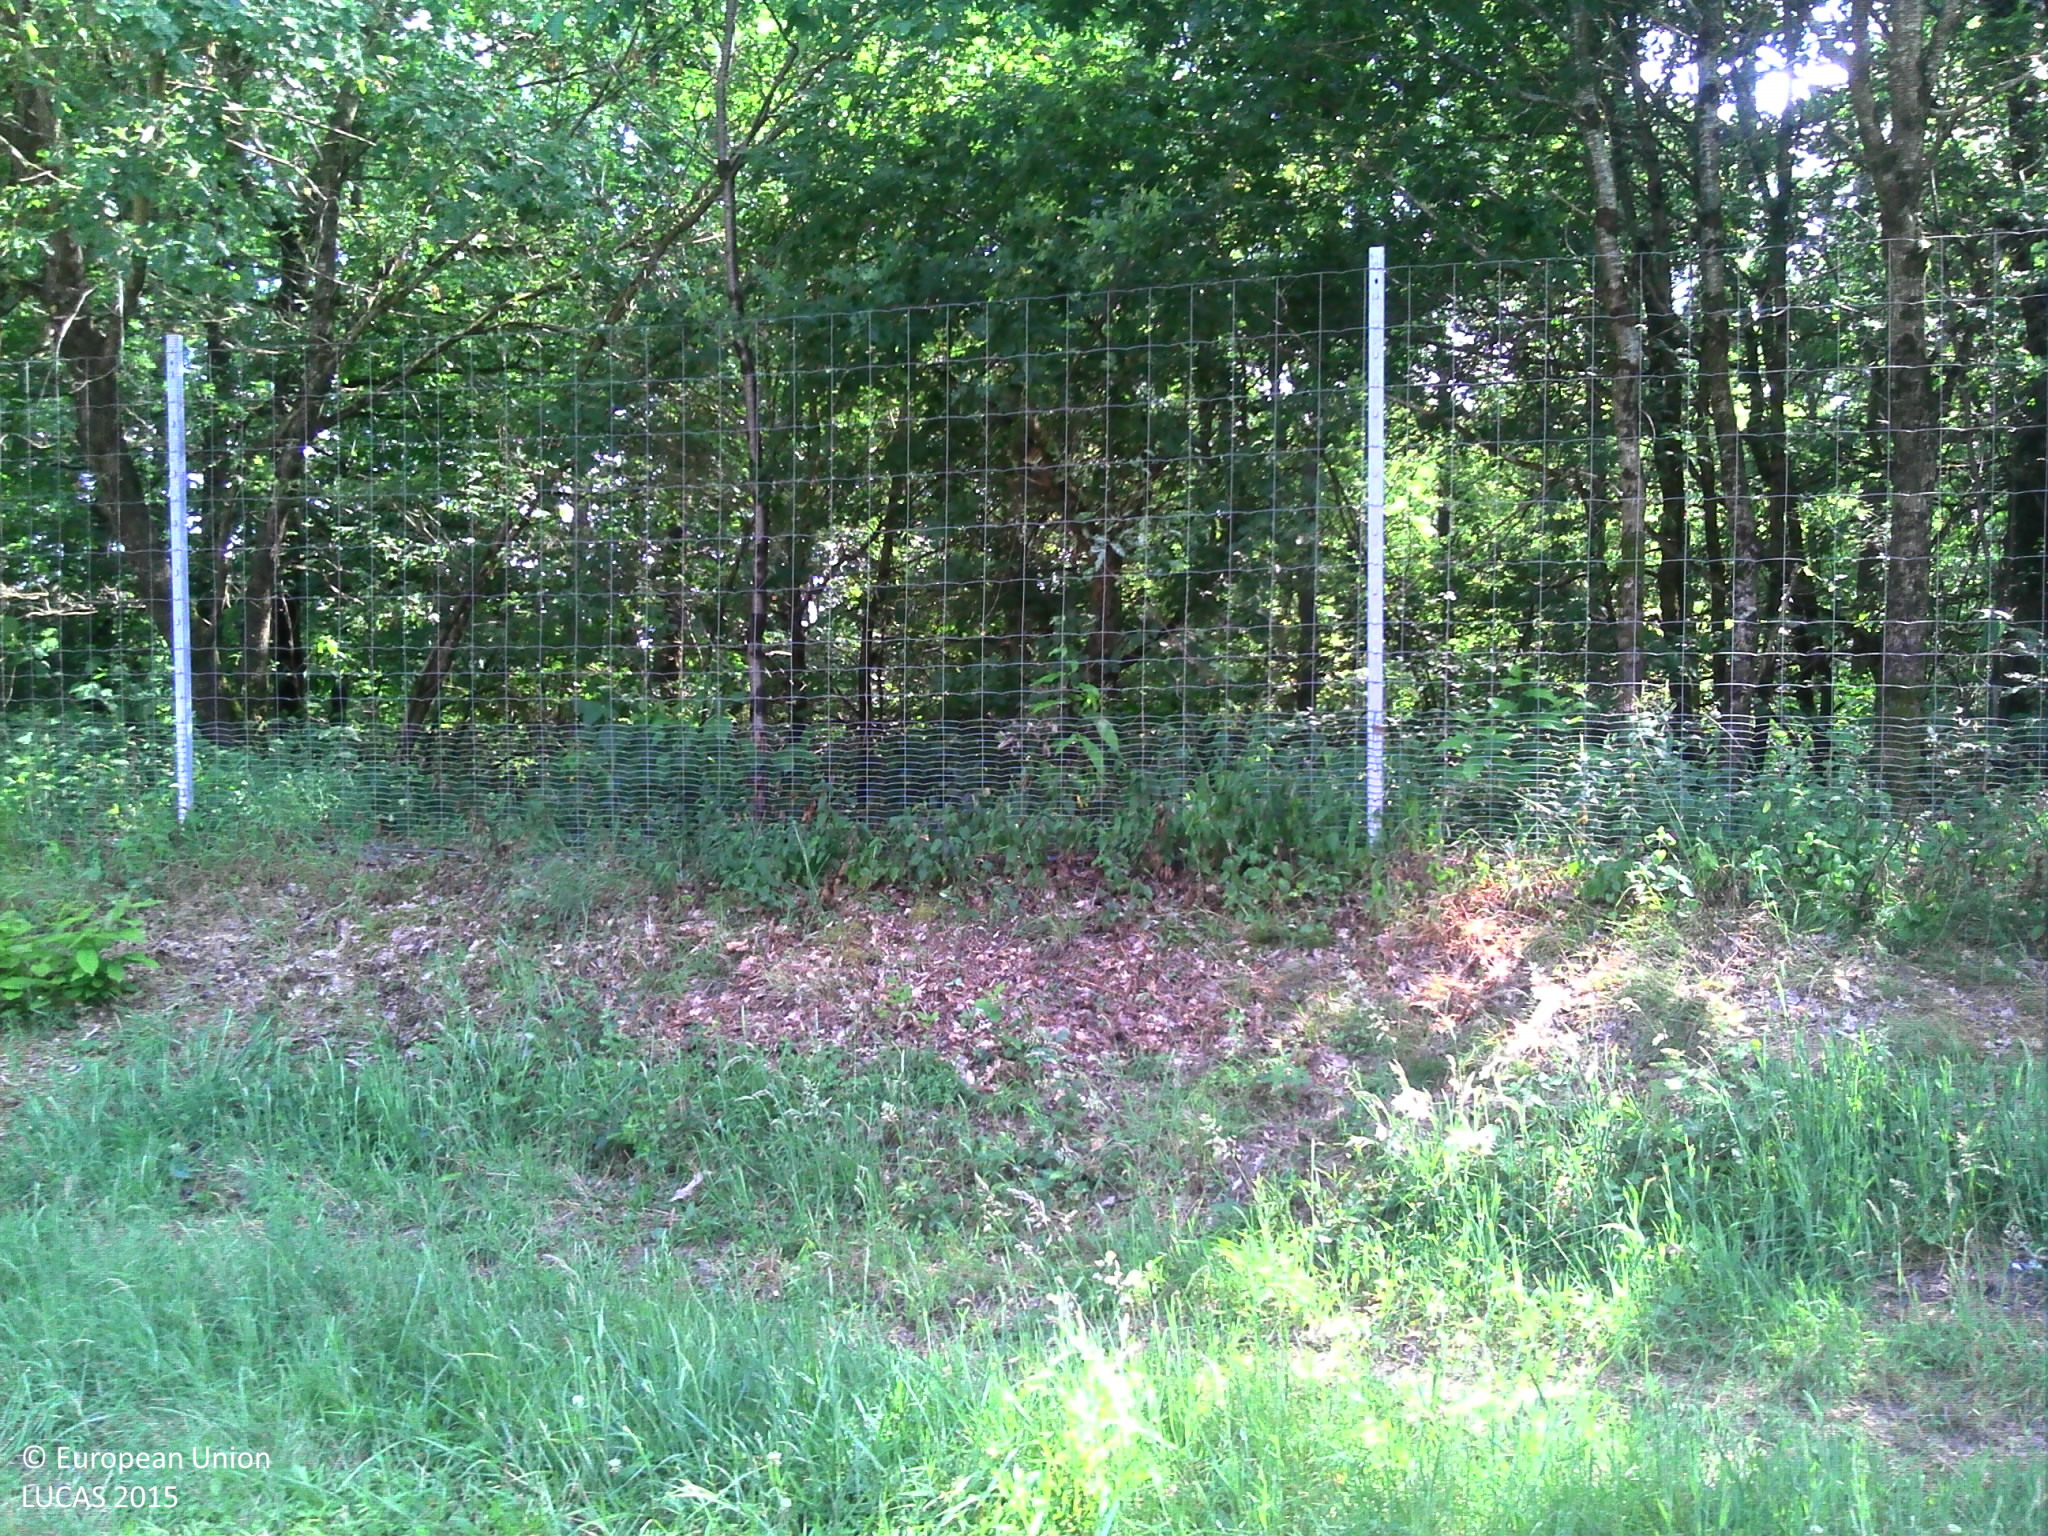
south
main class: Woodland
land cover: Broadleaved woodland
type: acidophilous oak and oak-birch forest
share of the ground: > 75 %
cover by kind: broadleaved forest trees 90 %, shrubs 5 %, herbaceous plants 5 %
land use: Forestry
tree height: > 5 m
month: June
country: FR
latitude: 46.7806
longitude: 0.5119
